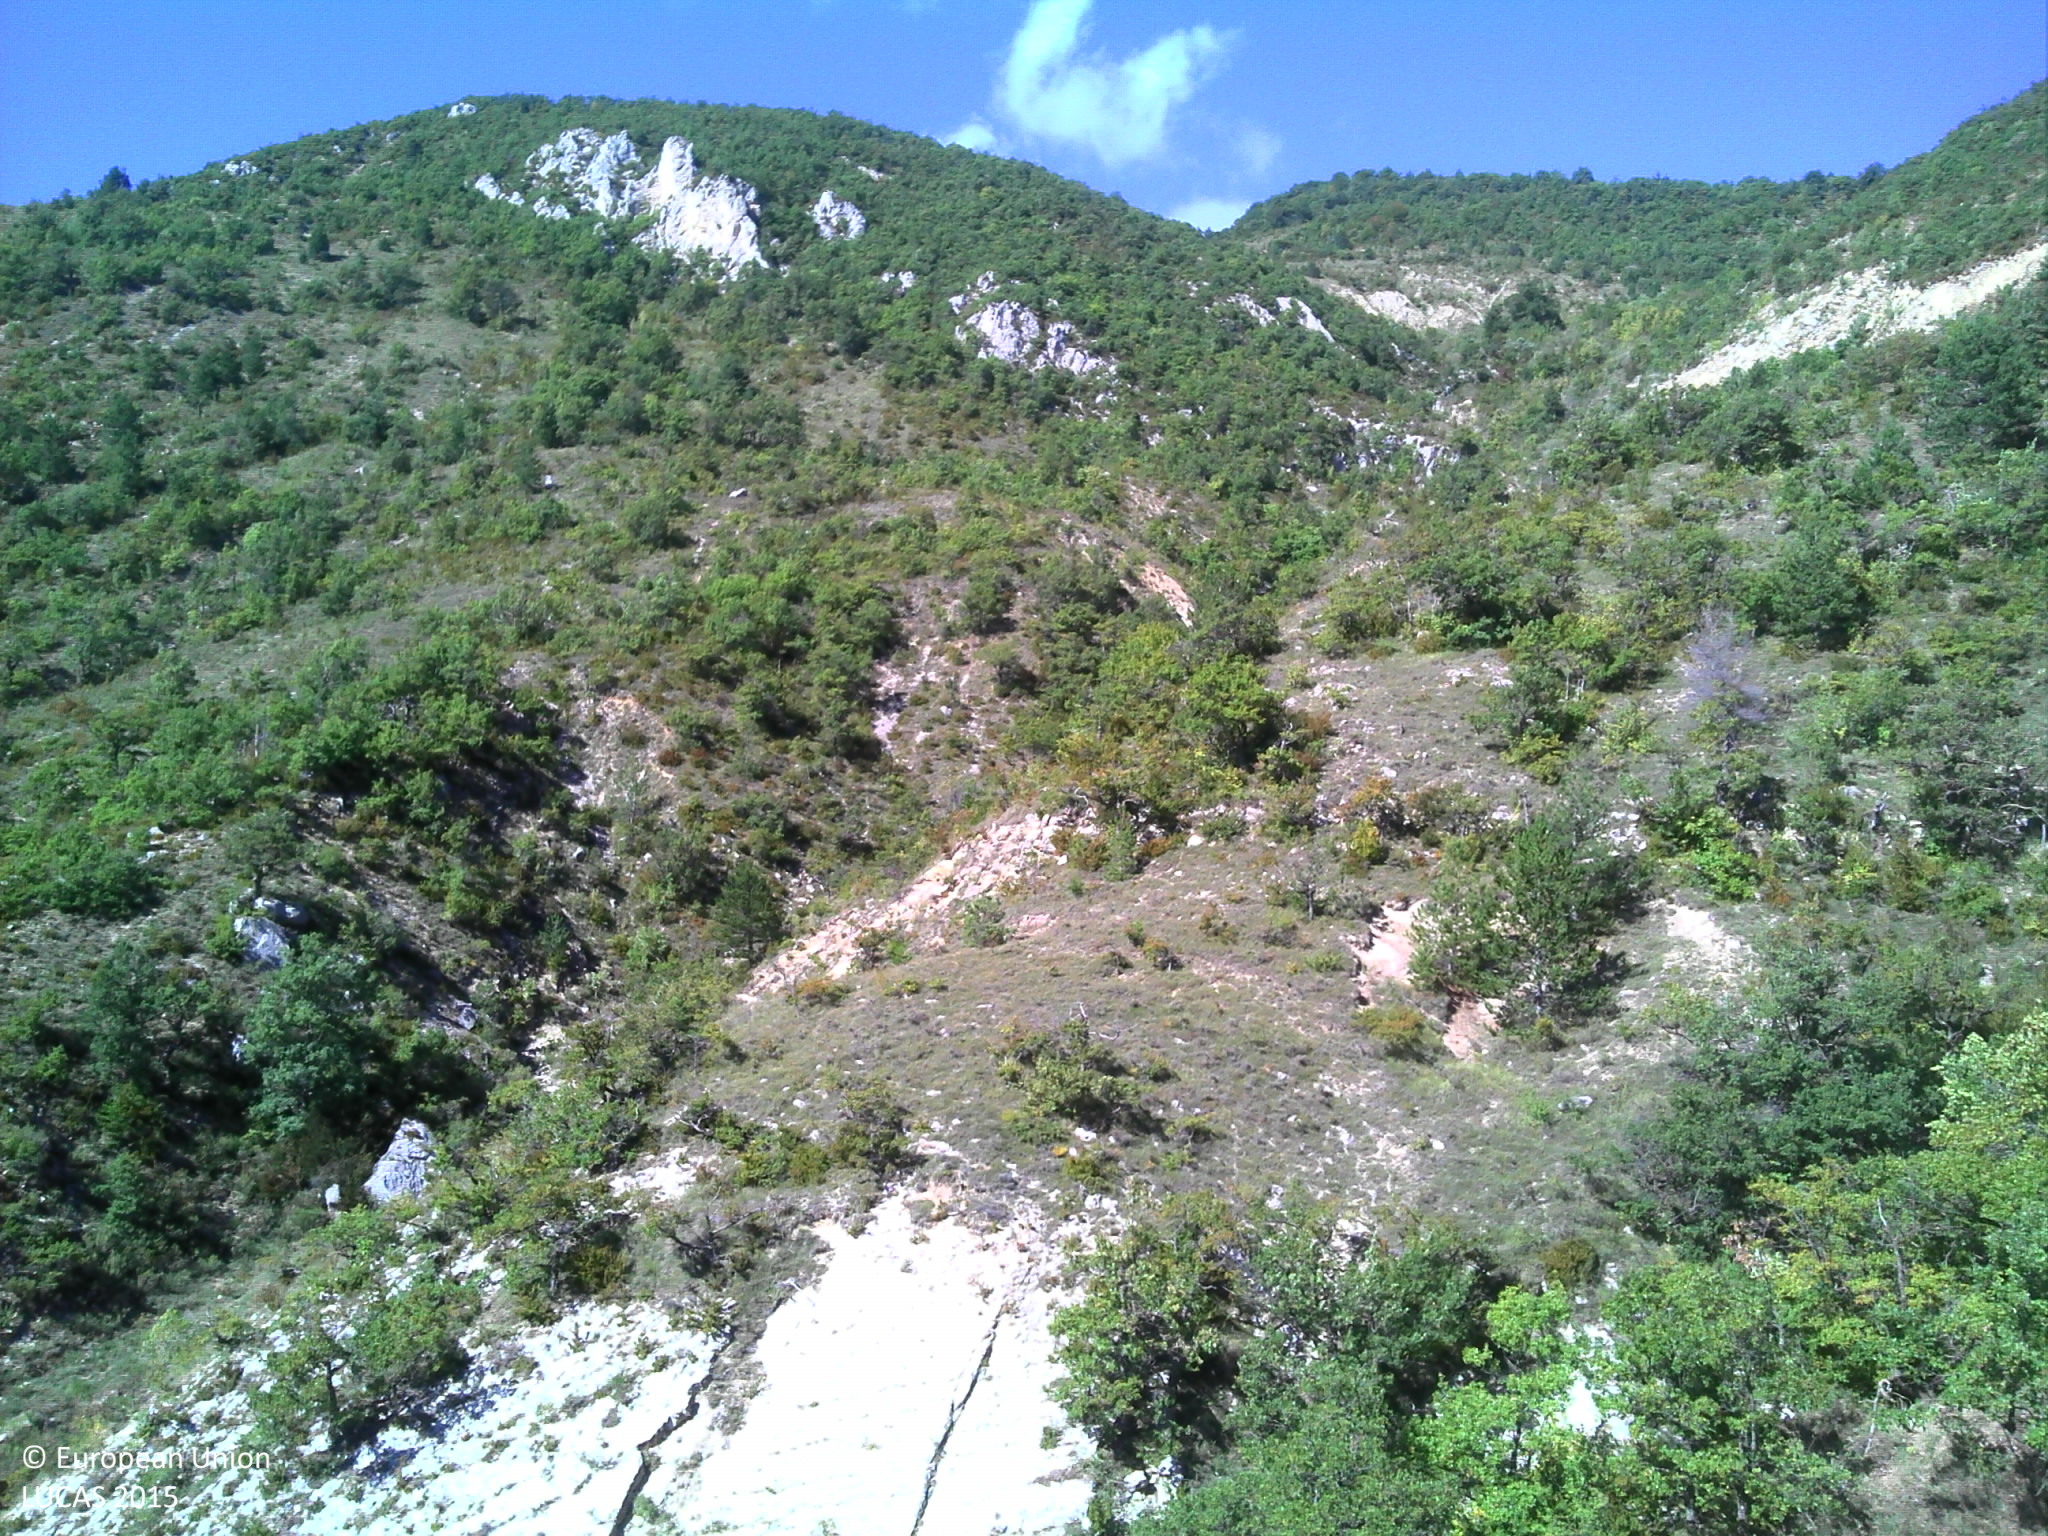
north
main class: Woodland
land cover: Pine dominated coniferous woodland
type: coniferous forest of the mediterranean region
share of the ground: > 75 %
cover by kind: coniferous forest trees 95 %, broadleaved forest trees 5 %
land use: Semi-natural and natural areas not in use
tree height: > 5 m
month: September
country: FR
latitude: 44.3717
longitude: 5.3264
